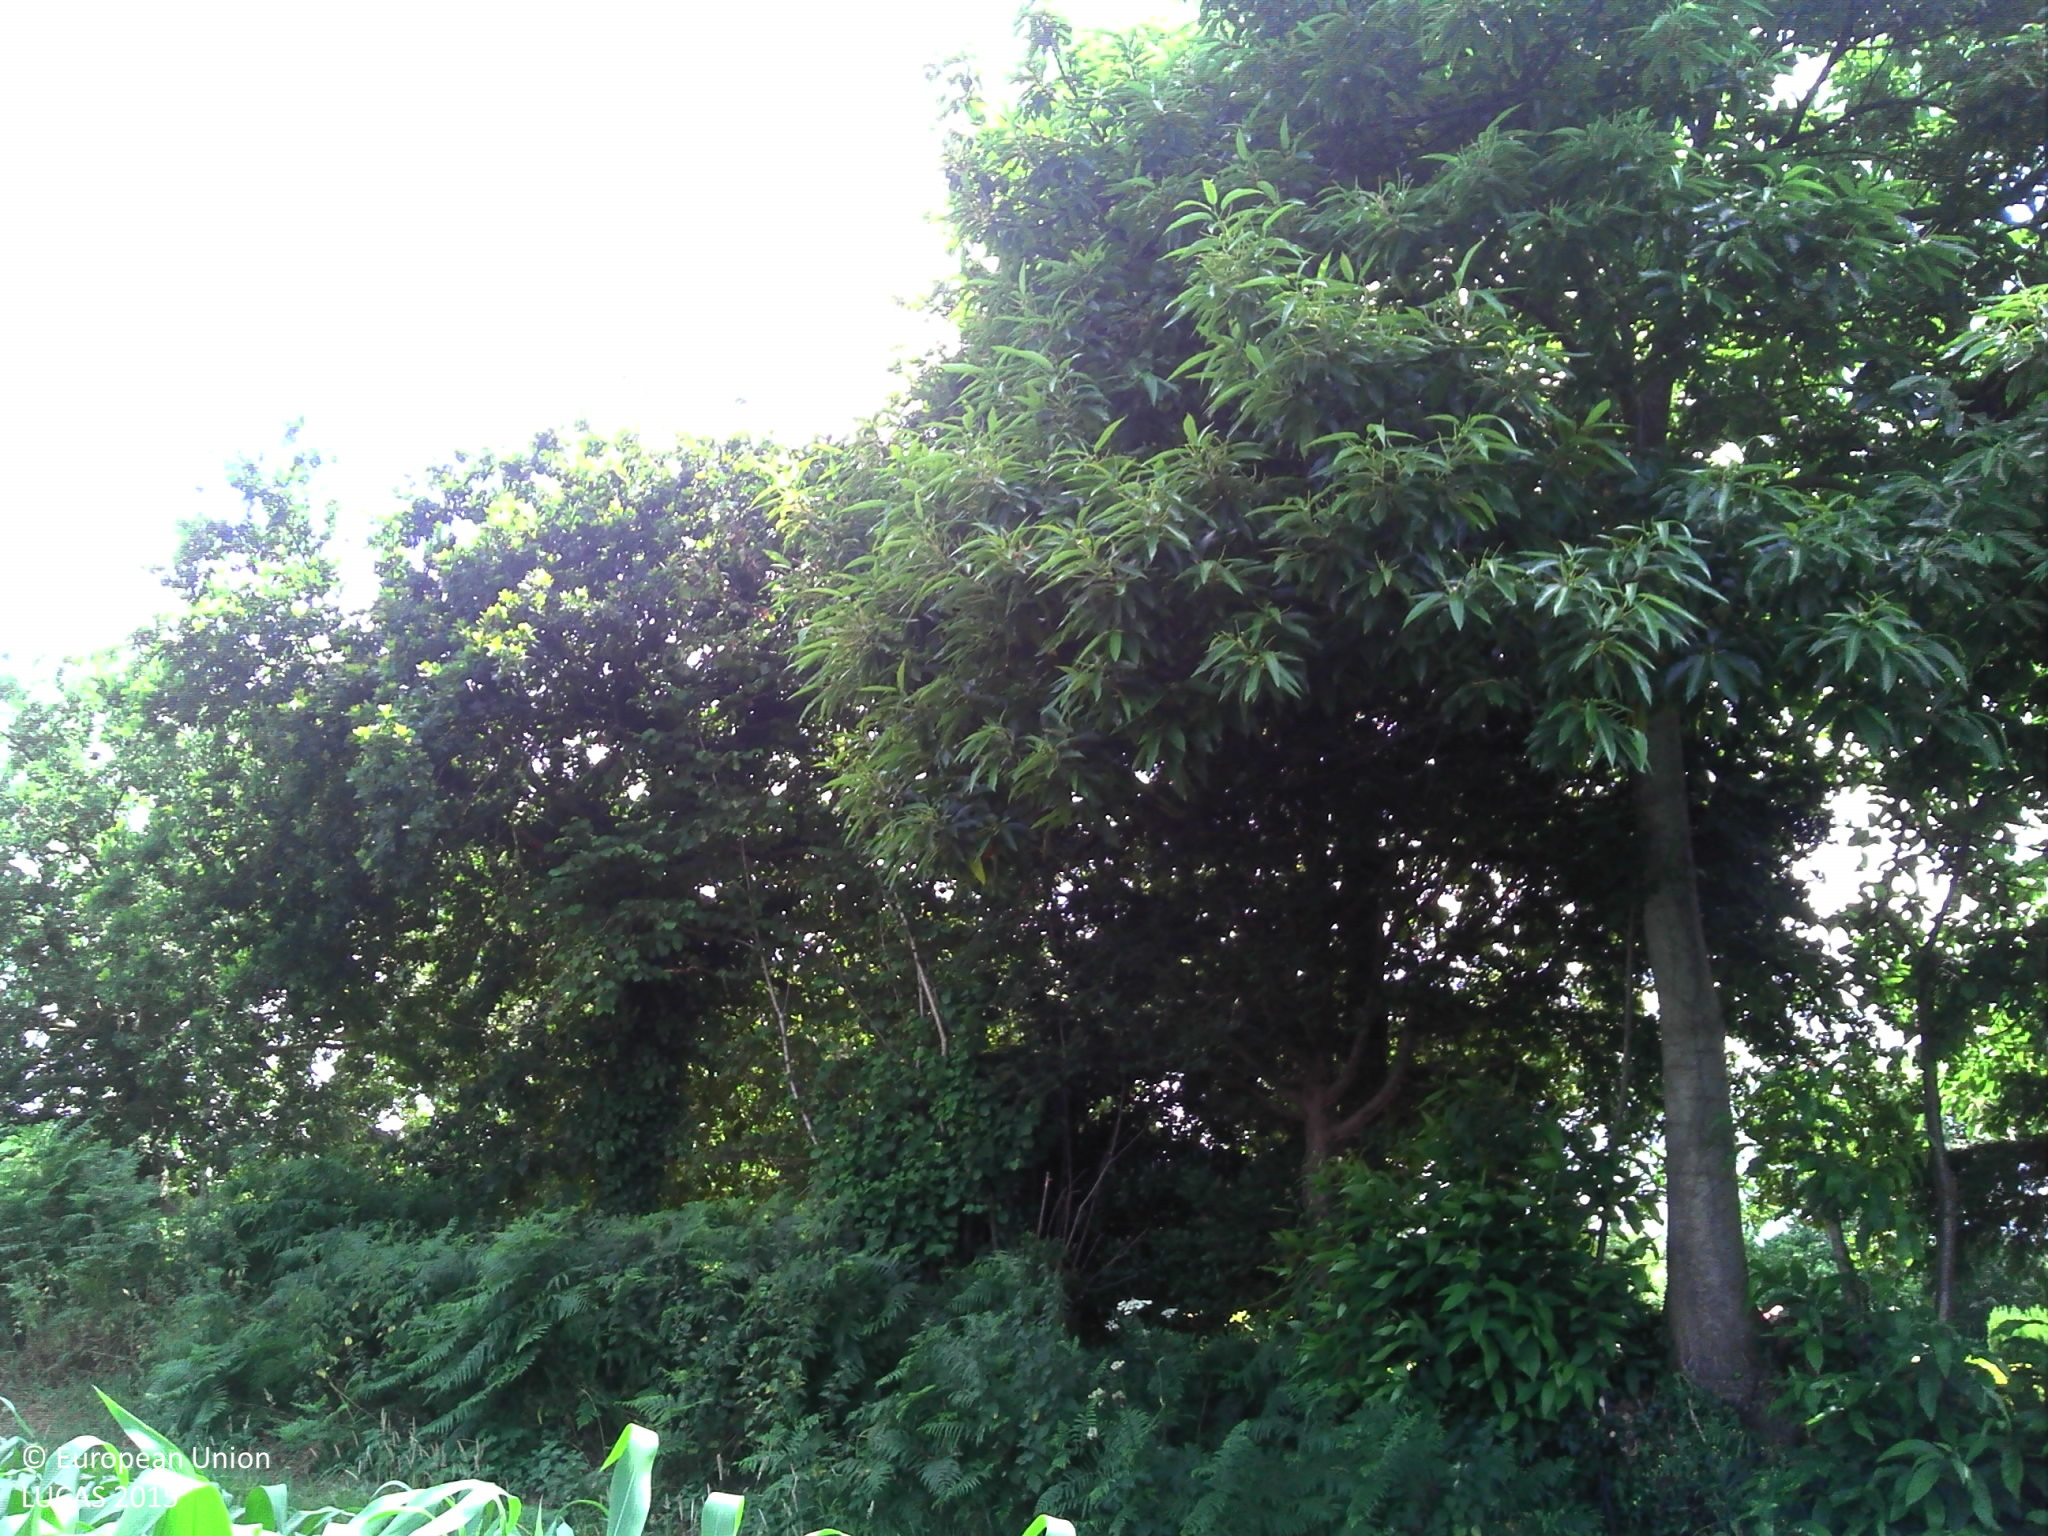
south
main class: Cropland
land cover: Maize
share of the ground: > 75 %
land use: Agriculture (excluding fallow land and kitchen gardens)
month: July
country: FR
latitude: 48.6323
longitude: -3.4716
